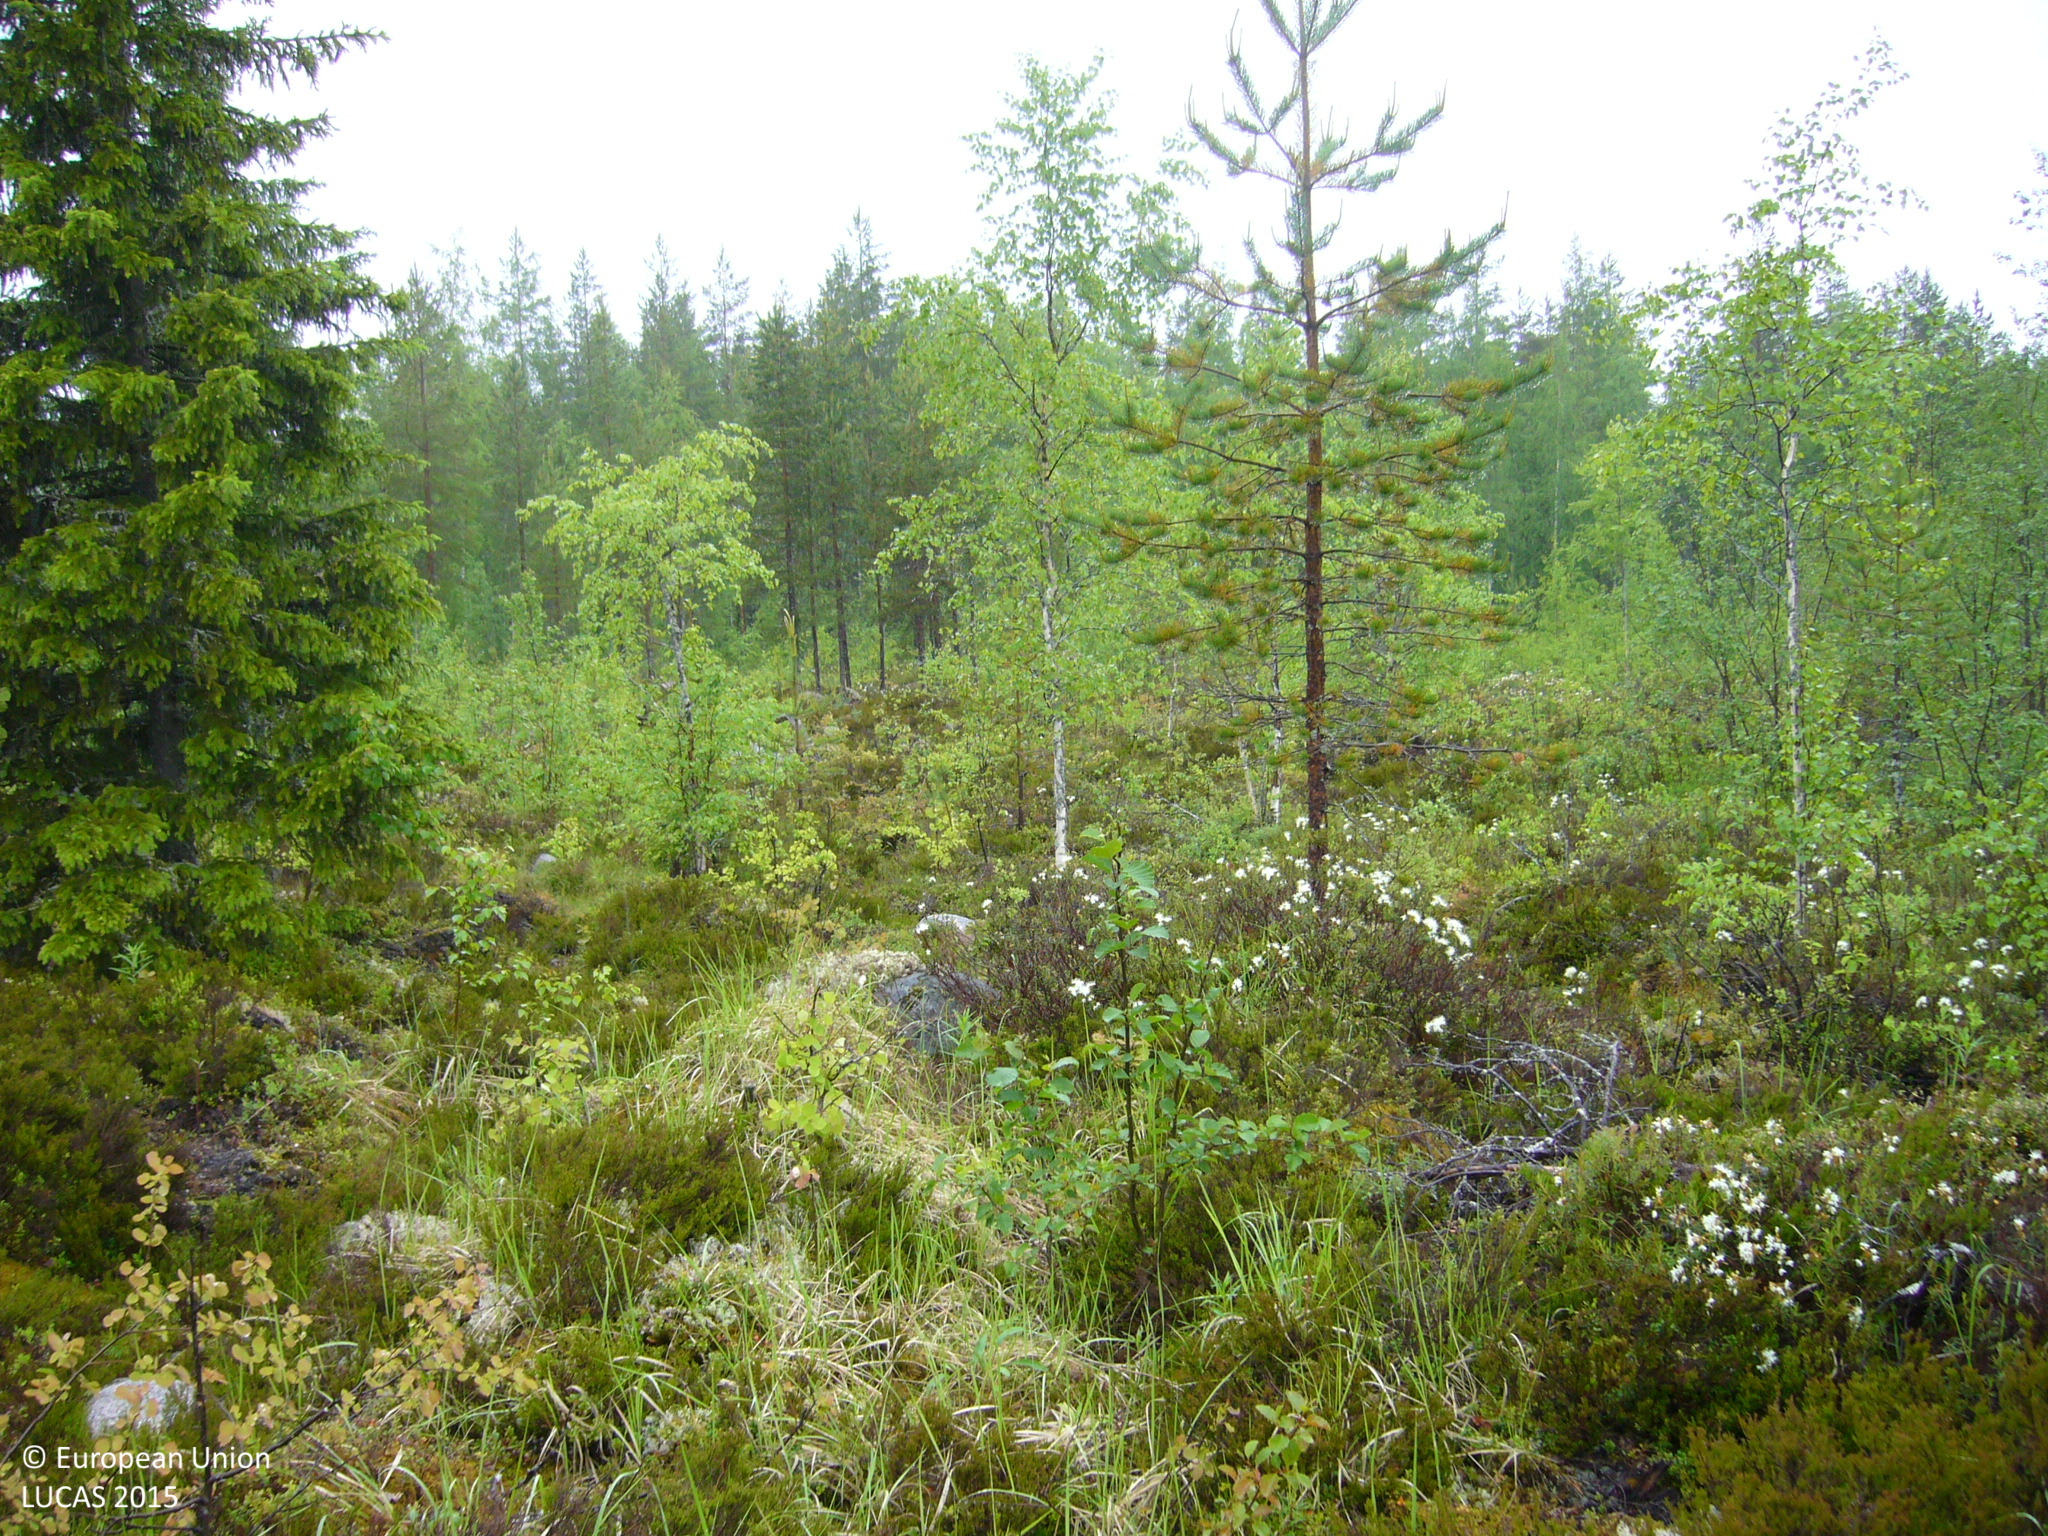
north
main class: Woodland
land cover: Pine dominated mixed woodland
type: boreal forest
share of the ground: 25 - 50 %
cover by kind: shrubs 65 %, coniferous forest trees 25 %, broadleaved forest trees 10 %
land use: Forestry
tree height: > 5 m
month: June
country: FI
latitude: 63.7685
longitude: 25.0331
